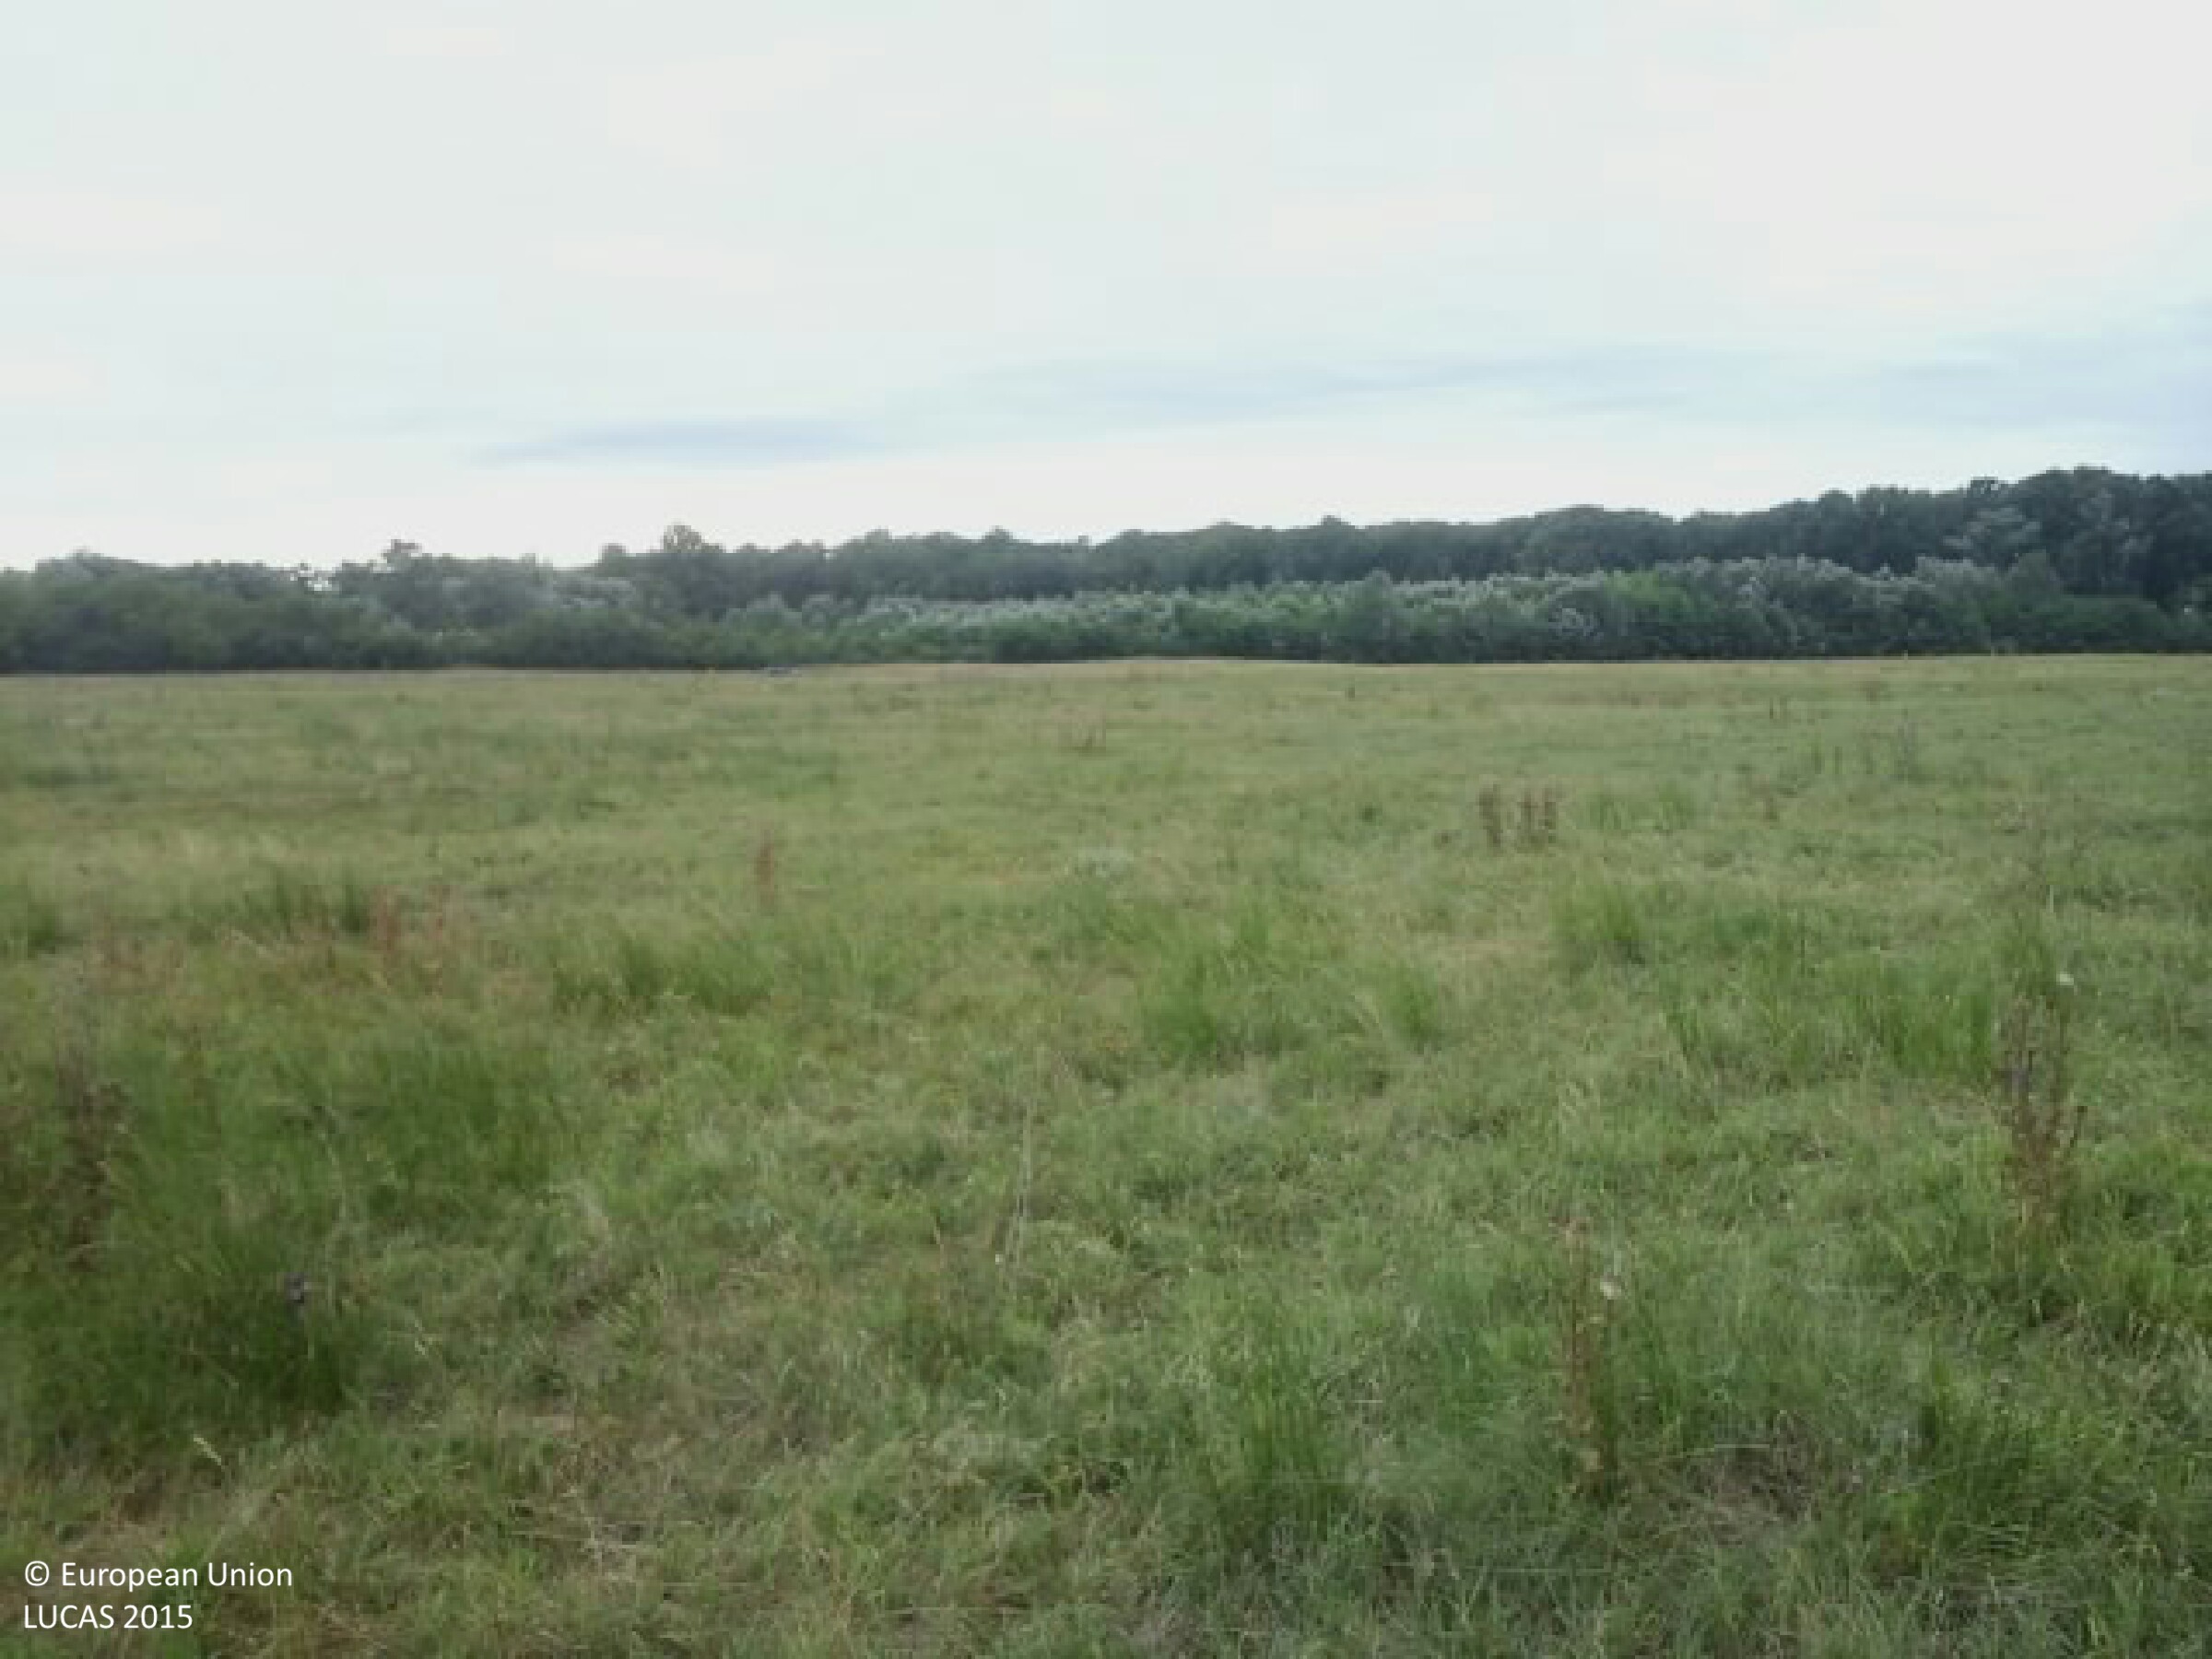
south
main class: Grassland
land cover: Grassland without tree/shrub cover
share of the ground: > 75 %
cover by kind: herbaceous plants 100 %
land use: Agriculture (excluding fallow land and kitchen gardens)
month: June
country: HU
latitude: 46.6798
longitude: 19.6018
